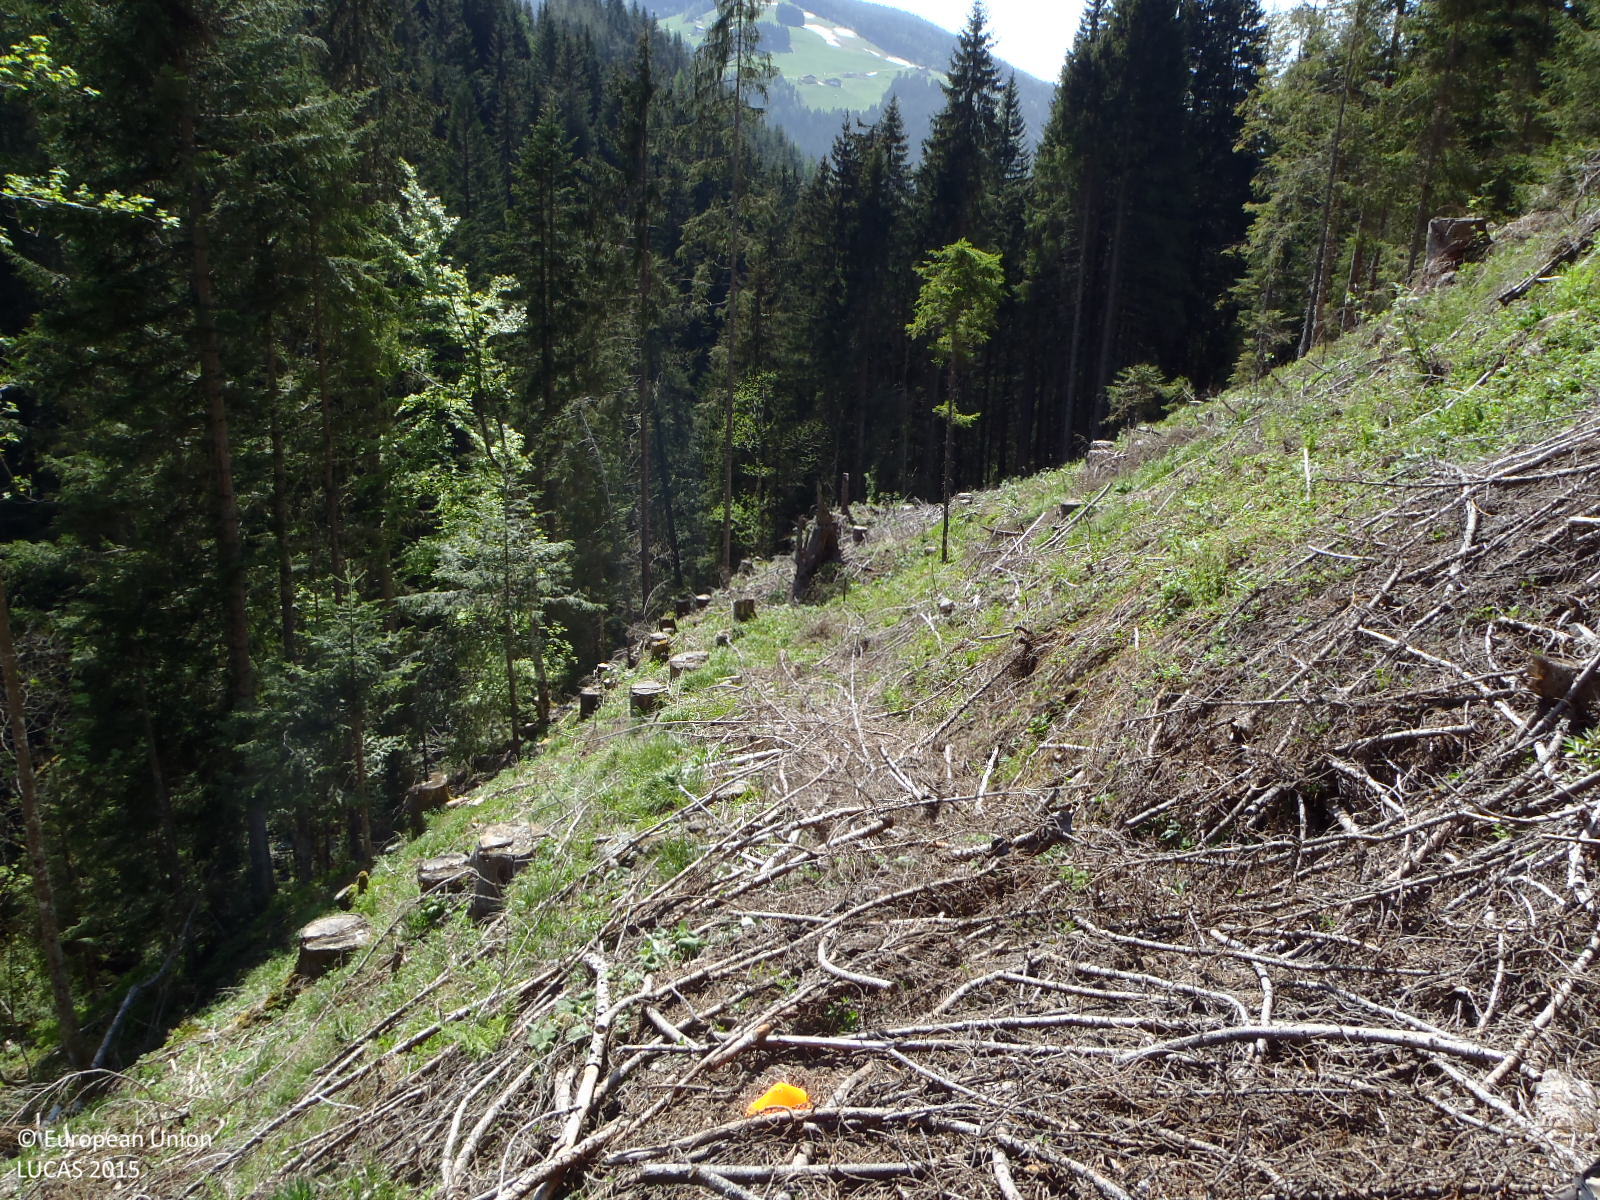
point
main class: Grassland
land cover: Spontaneously vegetated surfaces
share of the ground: 25 - 50 %
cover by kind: unconsolidated bare surface 65 %, herbaceous plants 30 %, shrubs 5 %
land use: Forestry
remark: Clear cut
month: May
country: AT
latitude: 47.3270
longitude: 13.3193
